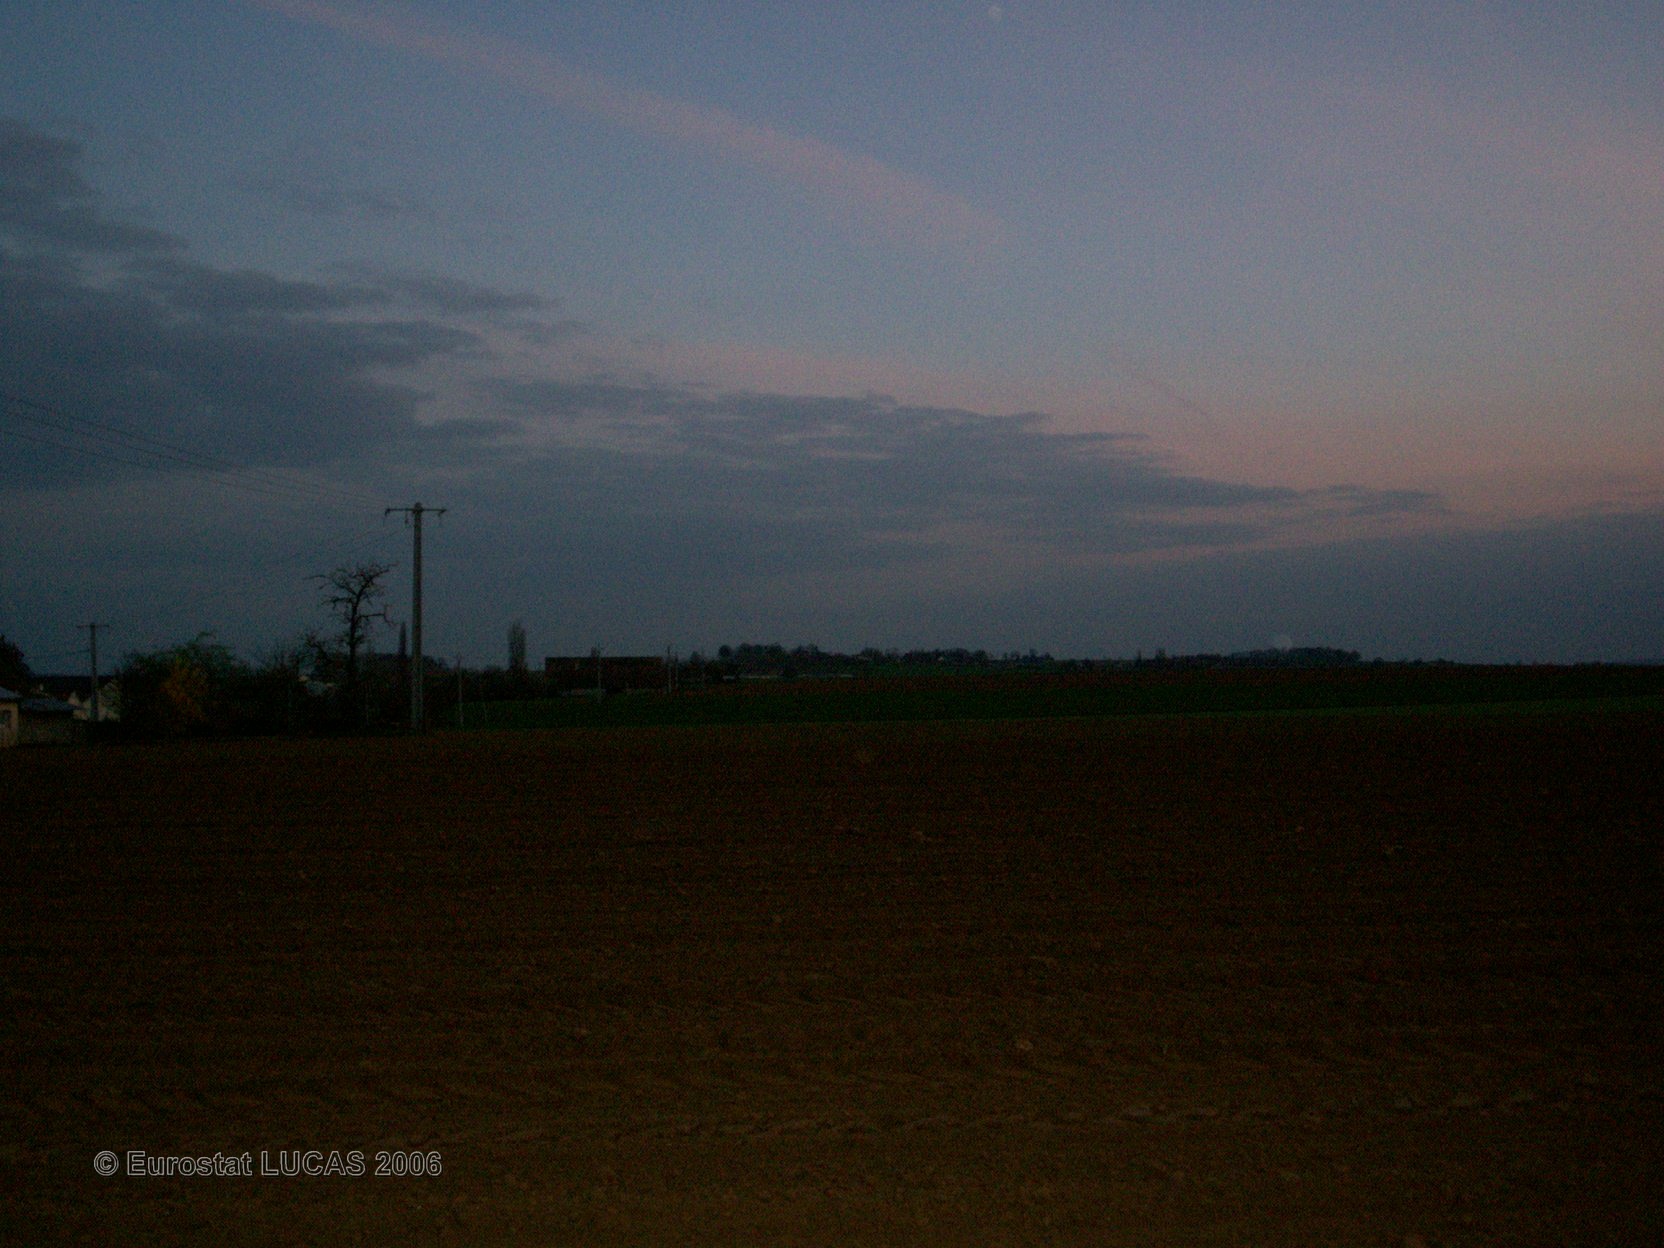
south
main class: Cropland
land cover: Maize
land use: Agriculture (excluding fallow land and kitchen gardens)
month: April
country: FR
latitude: 48.2863
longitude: 0.1204
